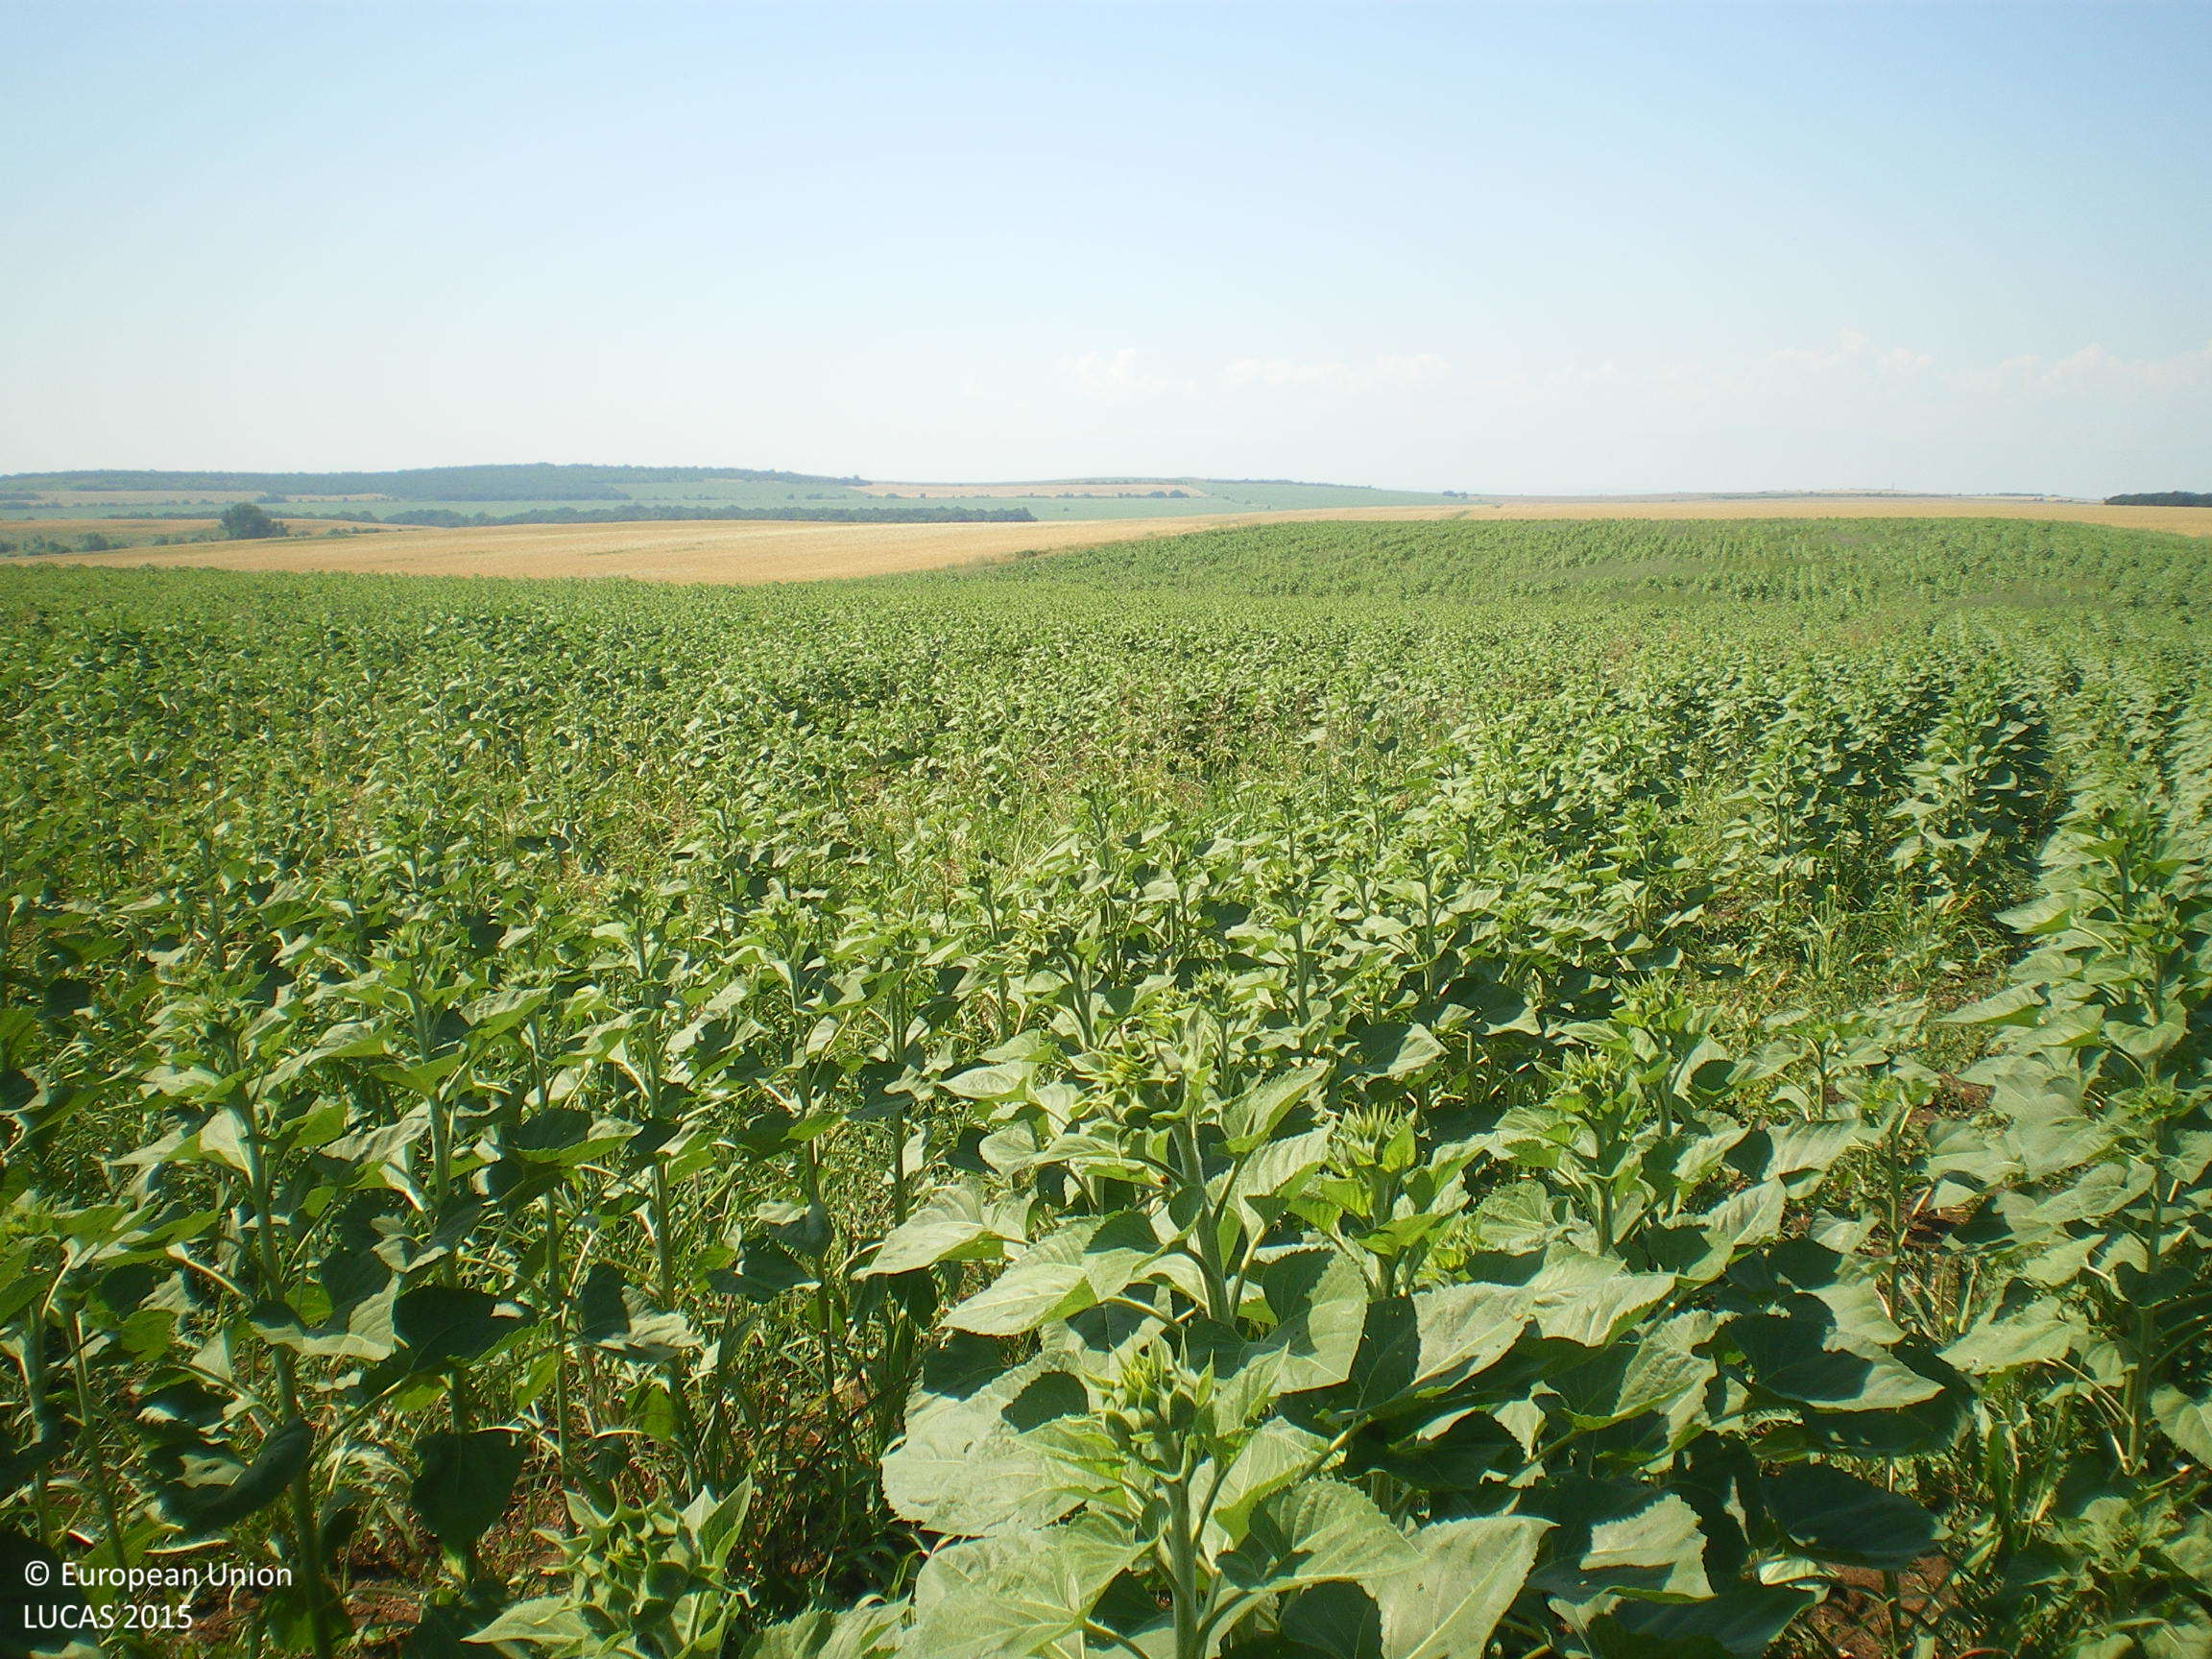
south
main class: Cropland
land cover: Sunflower
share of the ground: 50 - 75 %
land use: Agriculture (excluding fallow land and kitchen gardens)
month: June
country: BG
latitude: 42.3115
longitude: 25.1657
